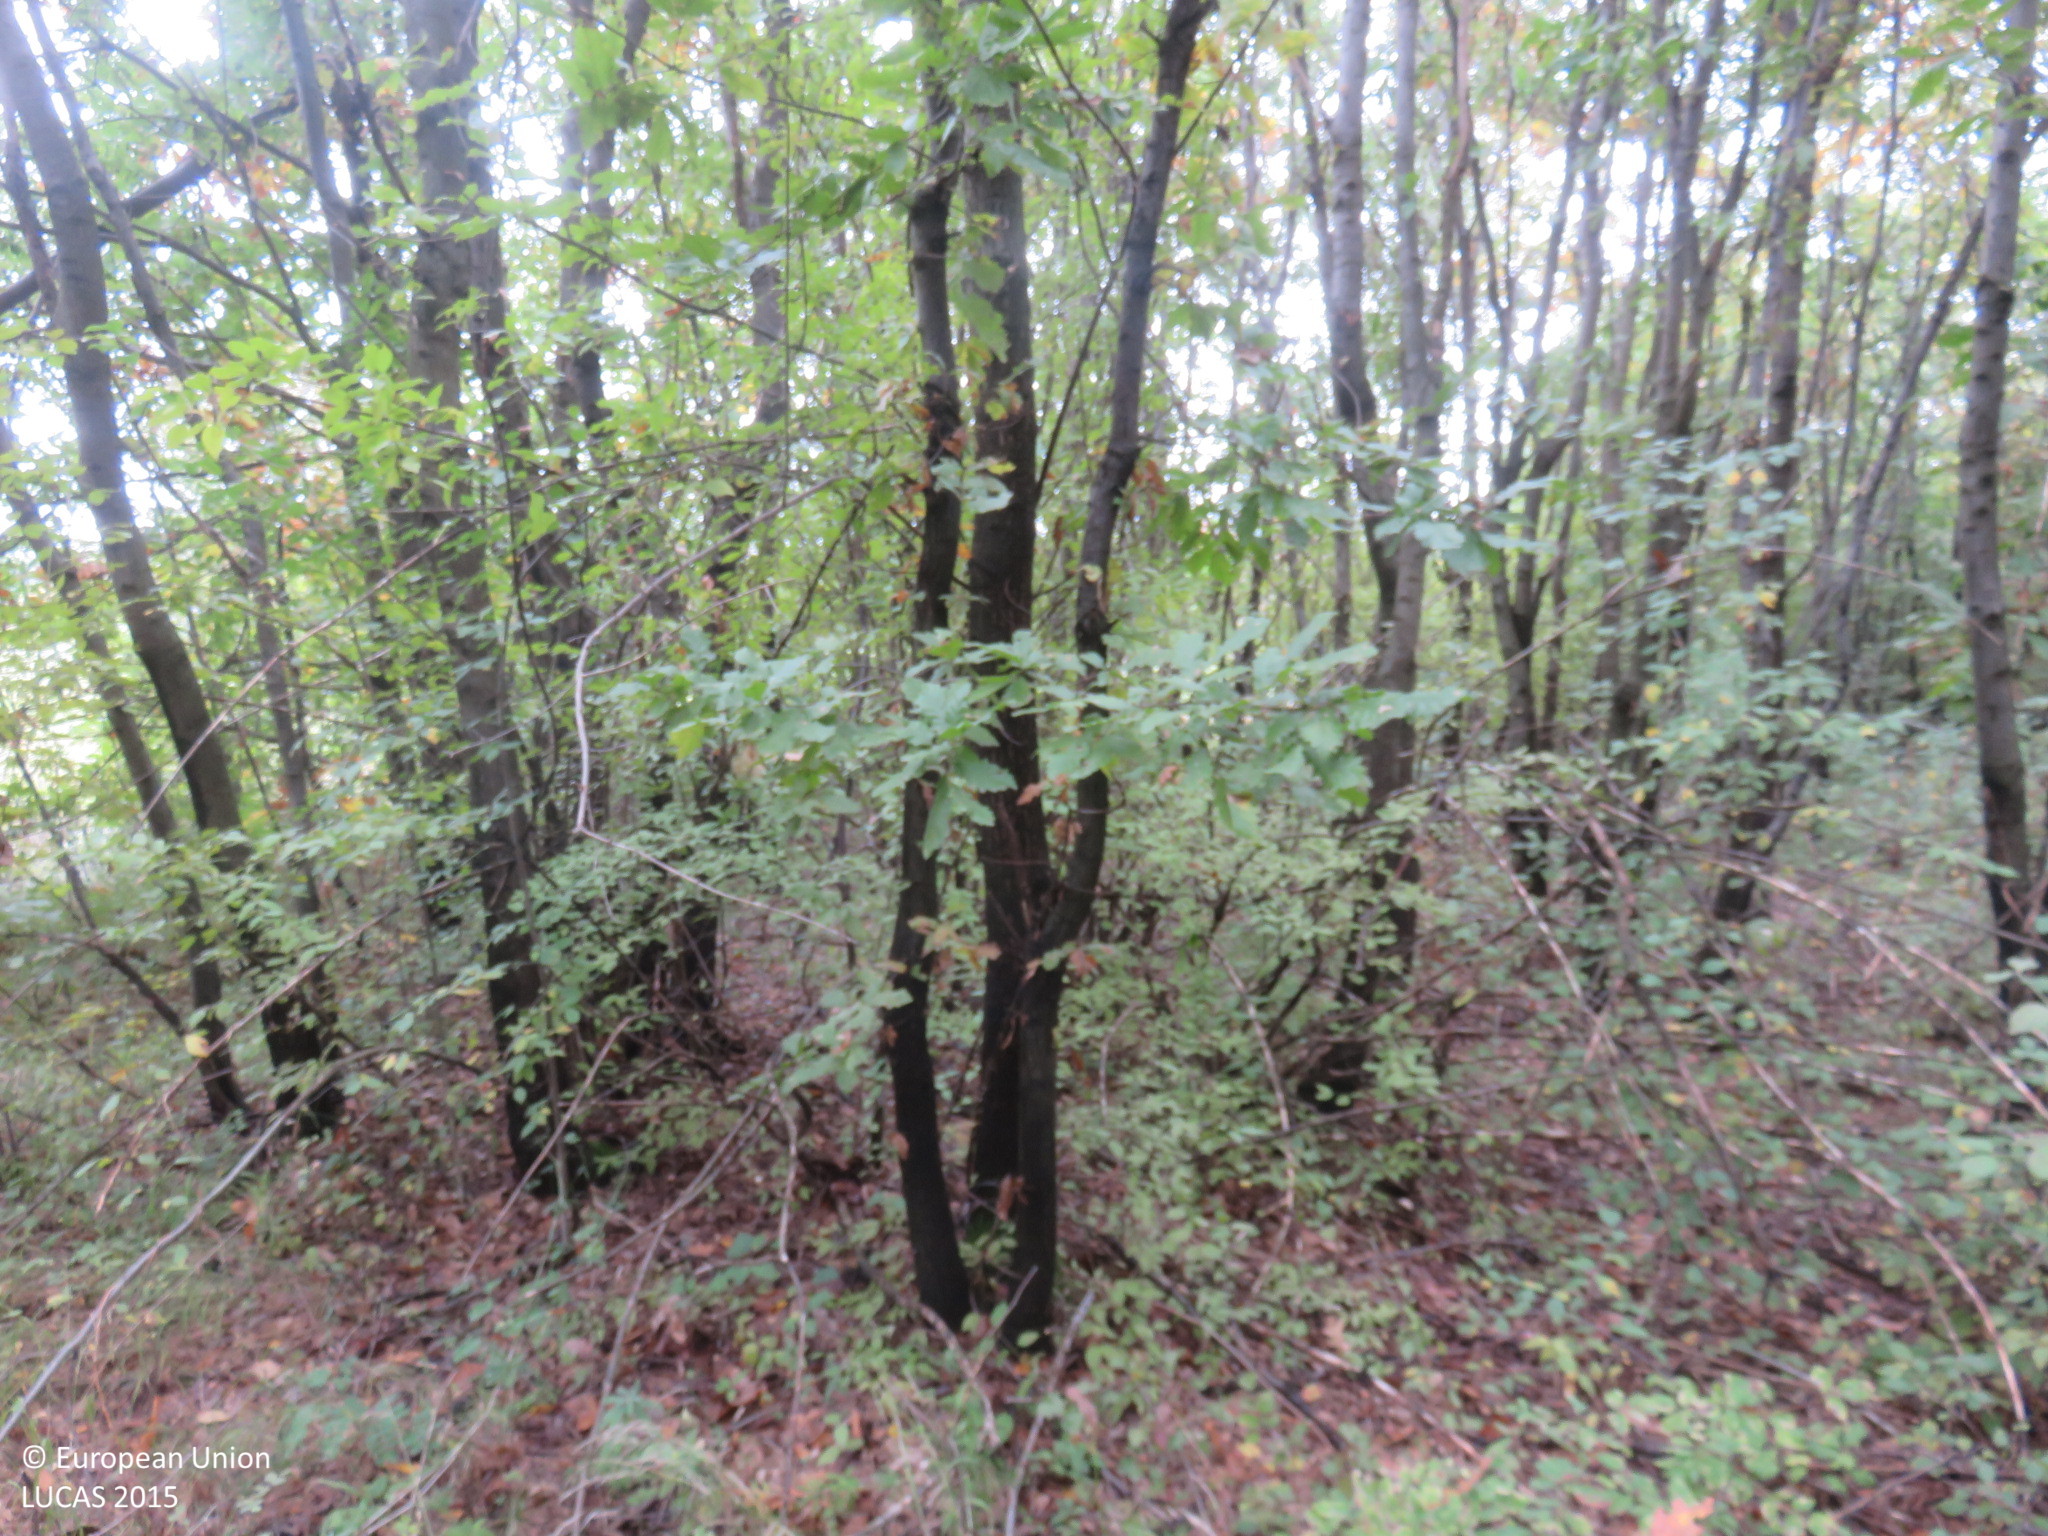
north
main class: Woodland
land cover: Broadleaved woodland
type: mesophytic deciduous forest
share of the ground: > 75 %
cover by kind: broadleaved forest trees 100 %
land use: Forestry
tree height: > 5 m
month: October
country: BG
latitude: 43.0919
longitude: 25.2187
